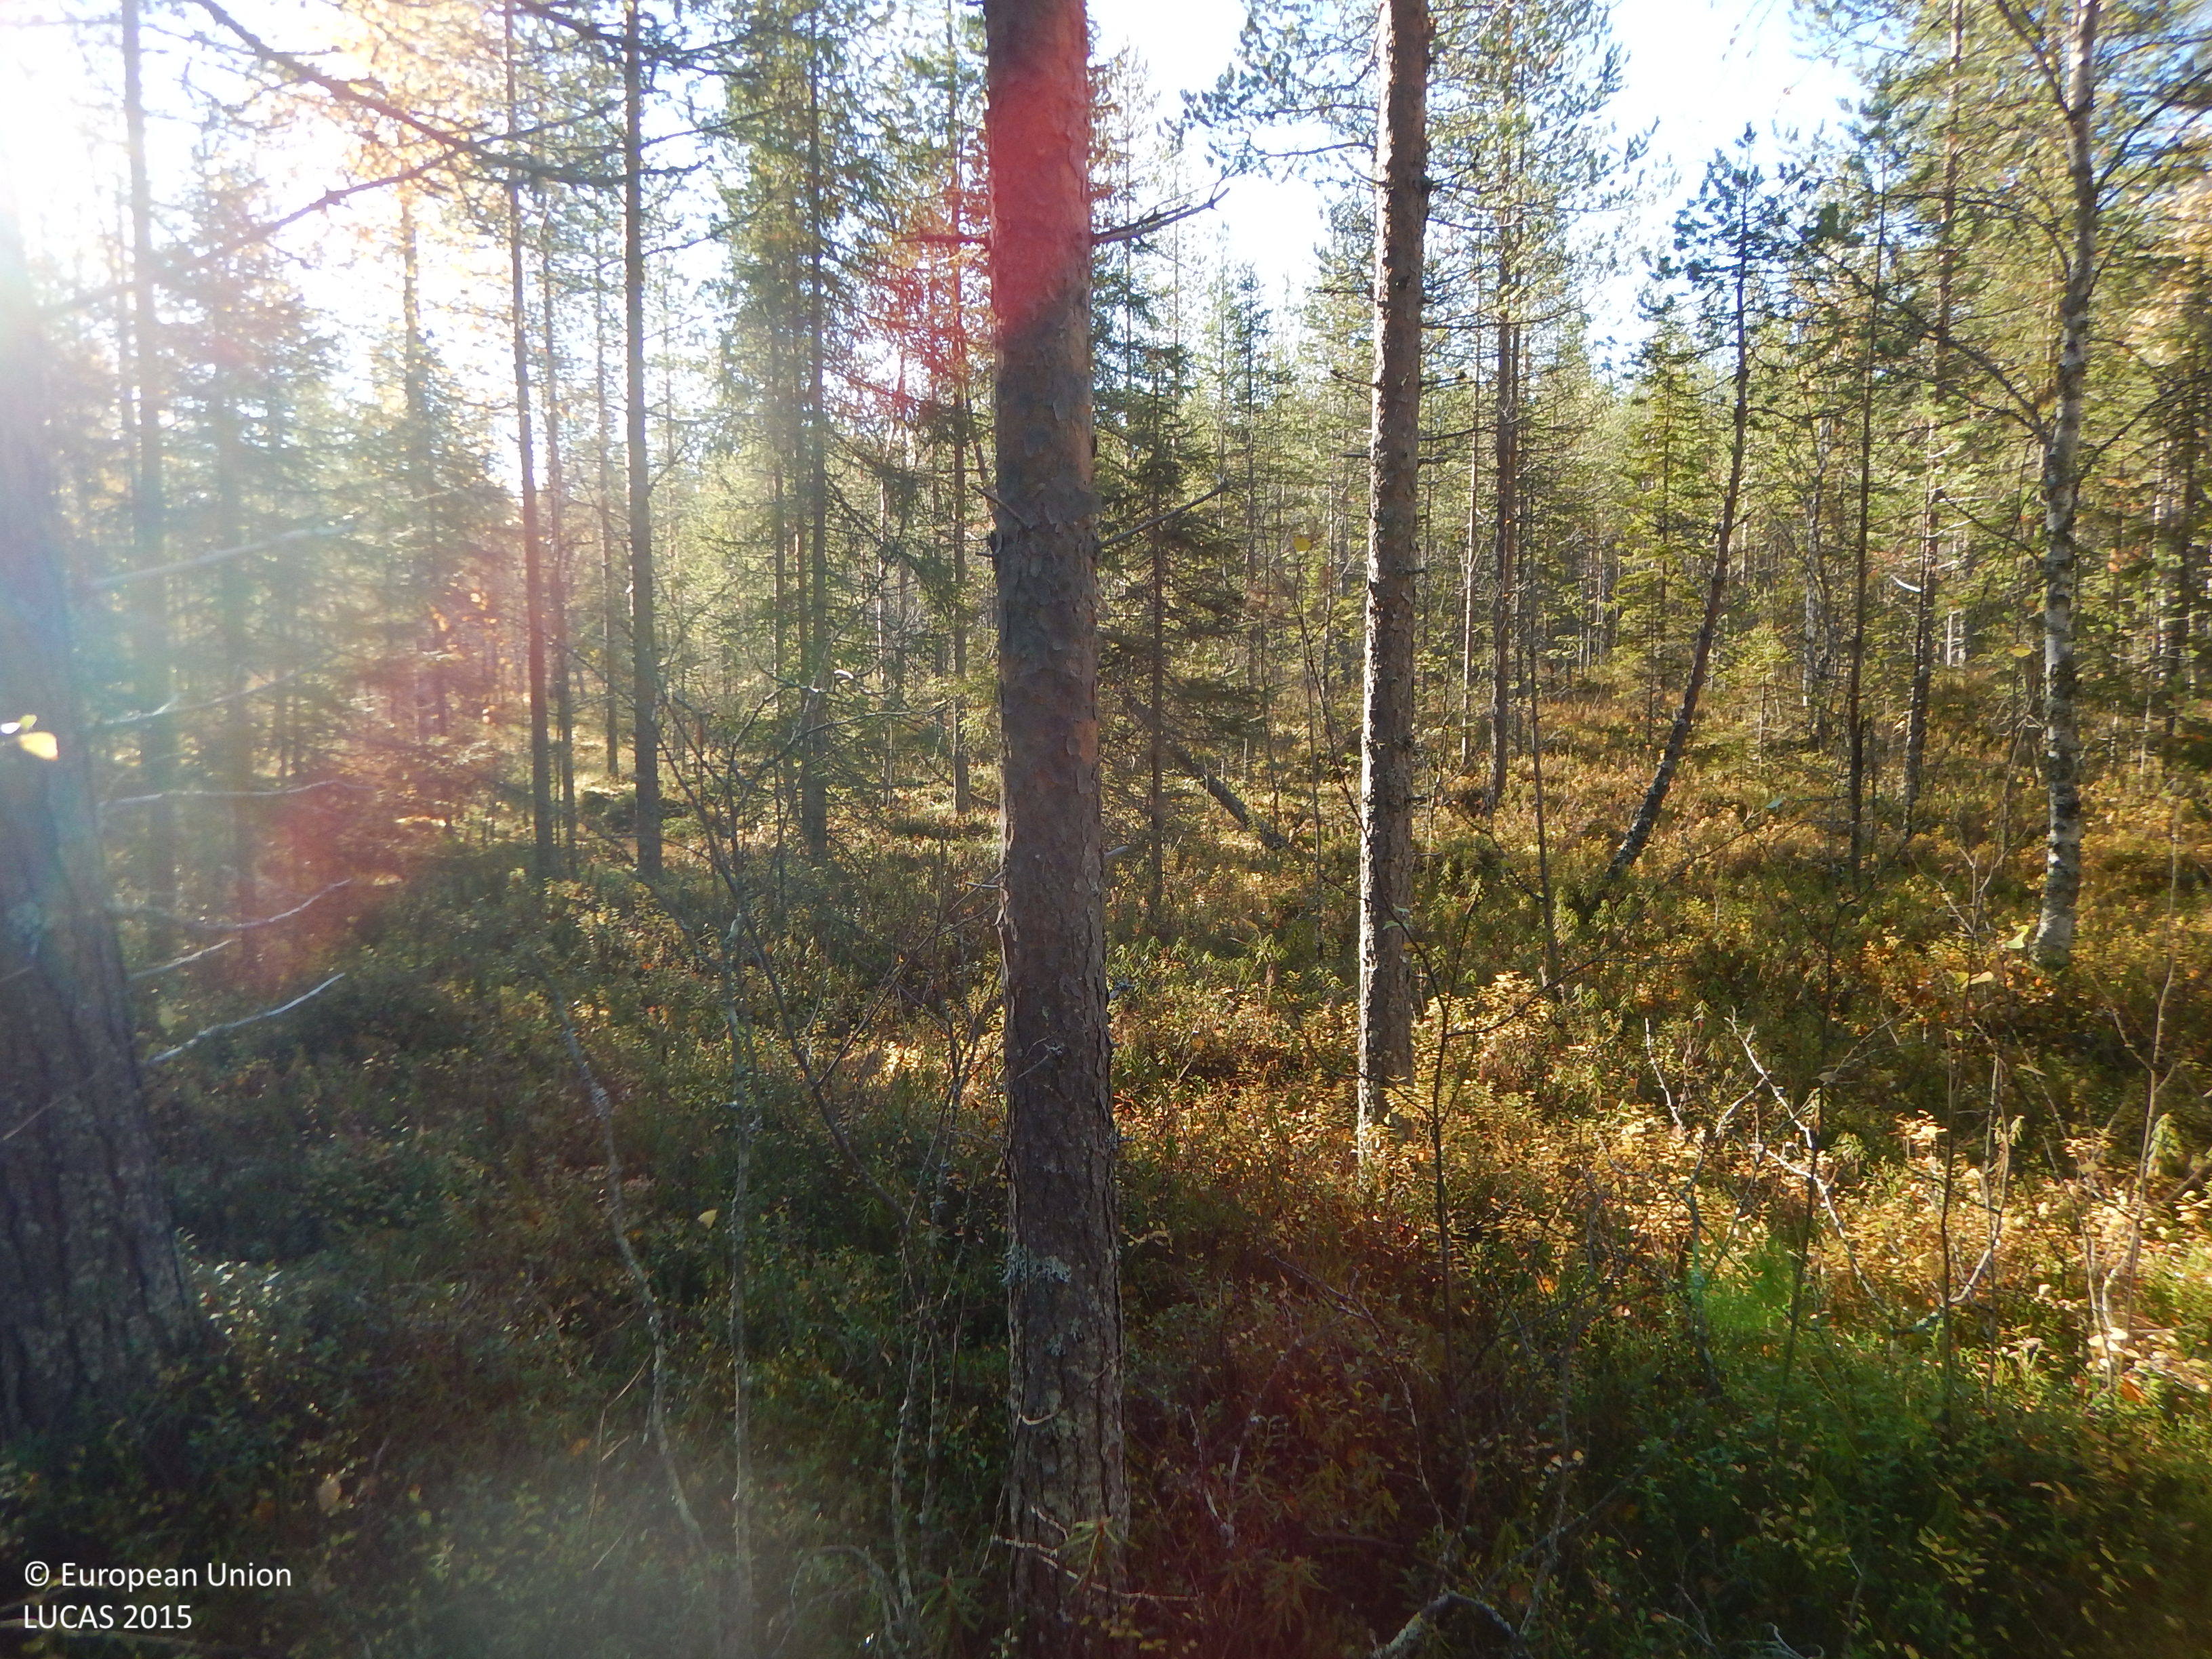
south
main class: Woodland
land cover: Pine dominated mixed woodland
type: boreal forest
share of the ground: 50 - 75 %
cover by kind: coniferous forest trees 40 %, lichens and mosses 20 %, broadleaved forest trees 15 %, shrubs 15 %, herbaceous plants 10 %
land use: Forestry
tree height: > 5 m
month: September
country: SE
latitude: 64.8893
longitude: 19.9172
